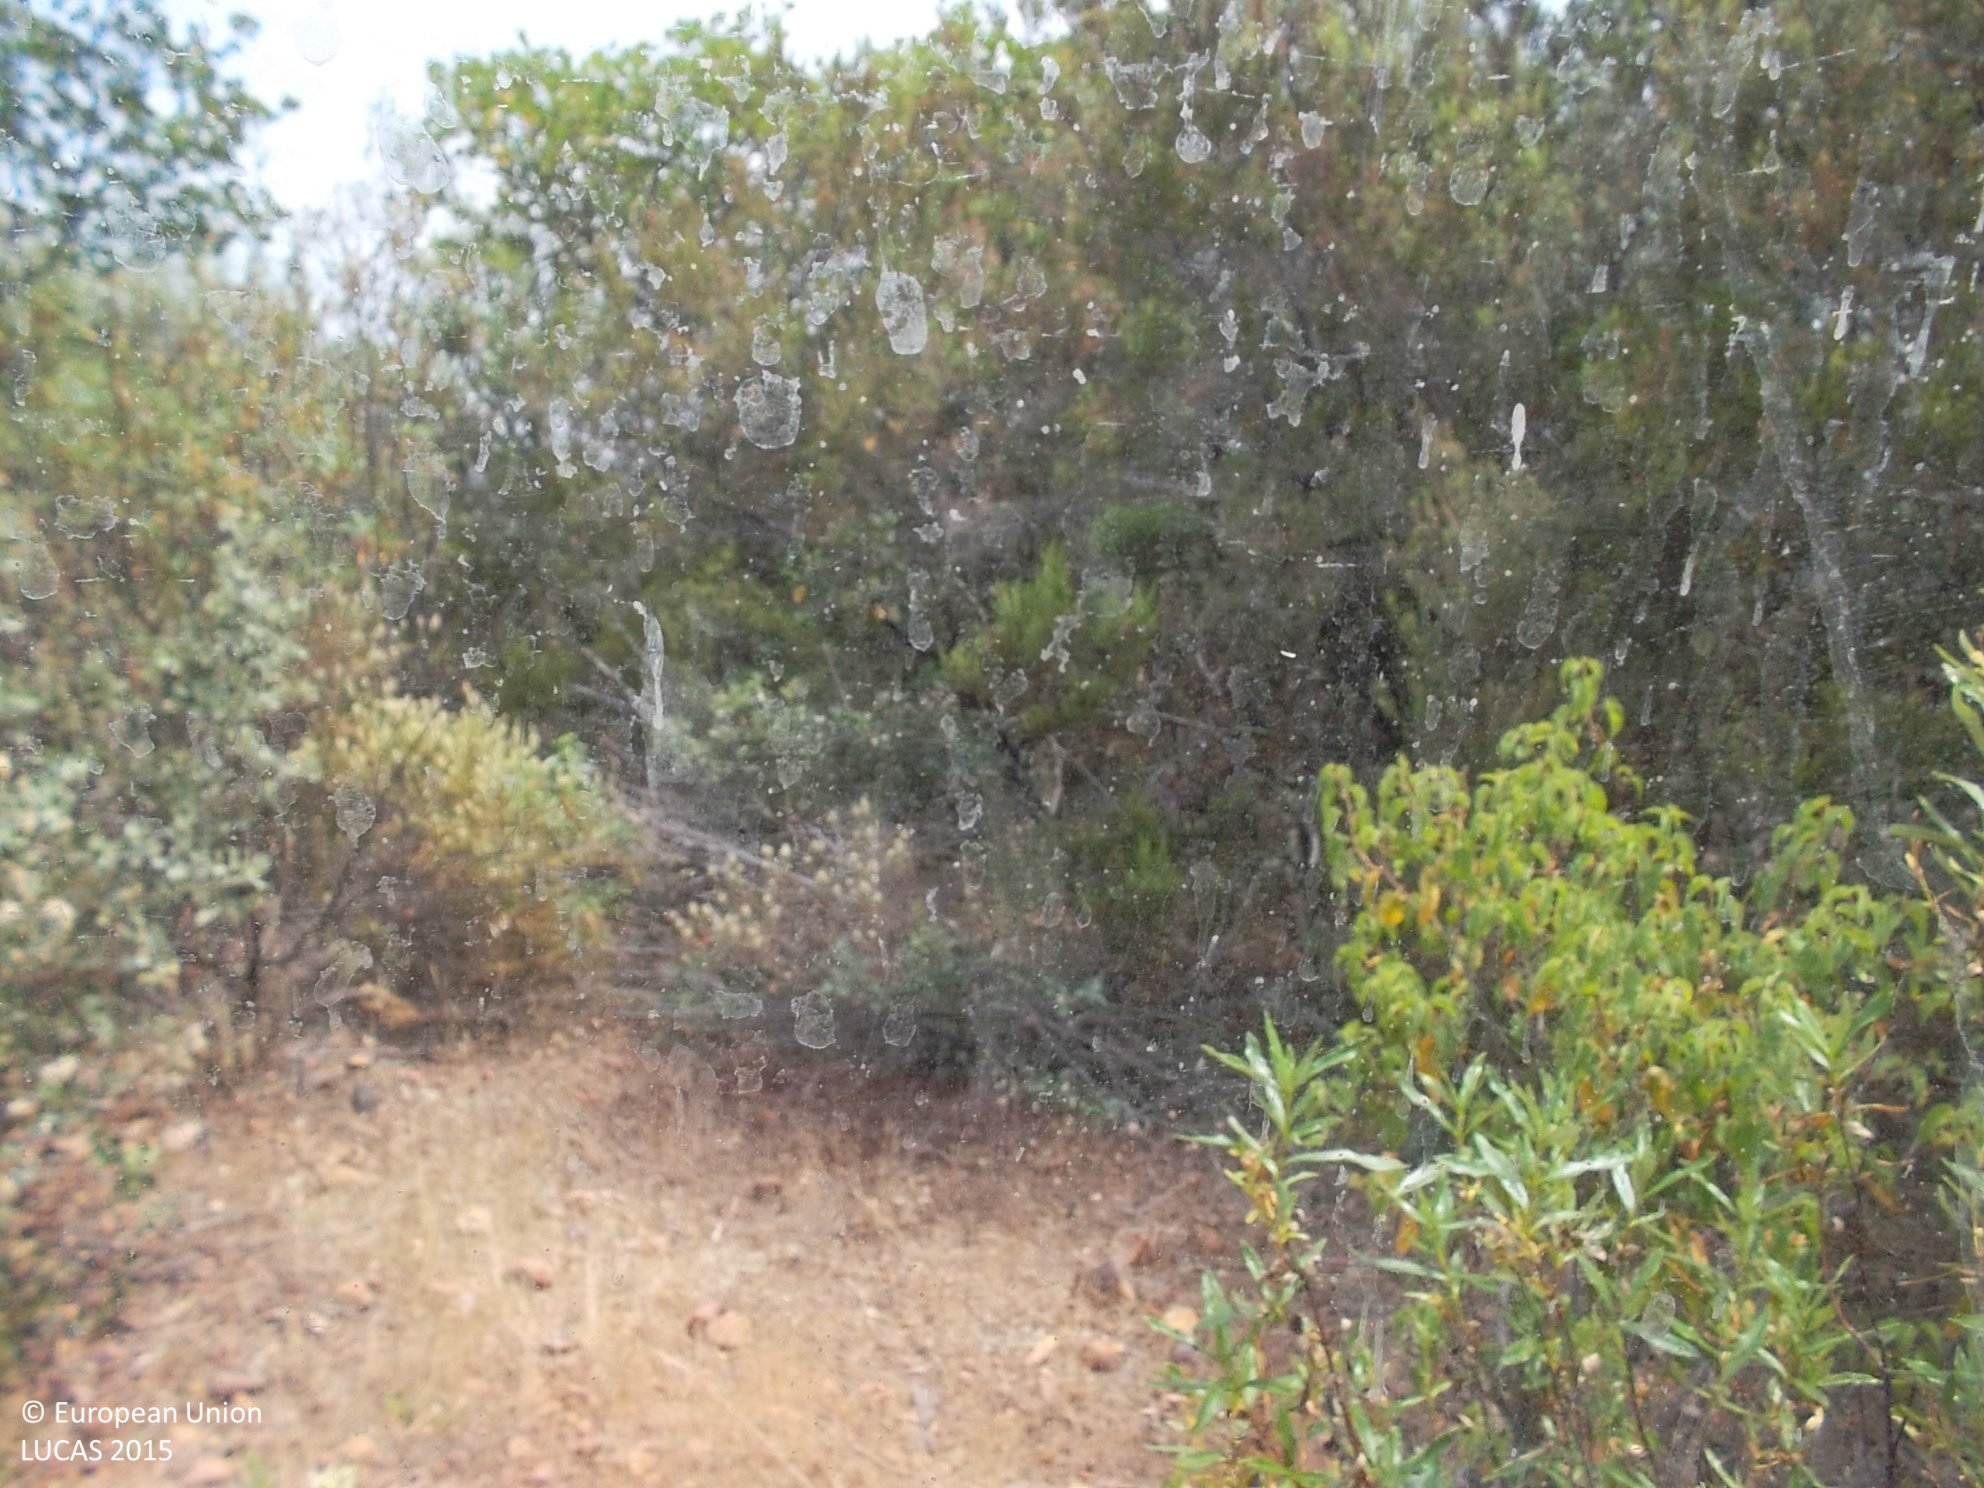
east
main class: Woodland
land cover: Broadleaved woodland
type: broadleaved evergreen forest
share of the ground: 50 - 75 %
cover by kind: shrubs 60 %, broadleaved forest trees 40 %
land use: Forestry
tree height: > 5 m
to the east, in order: Broadleaved woodland; Shrubland with sparse tree cover
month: June
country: ES
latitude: 39.1757
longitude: -4.9114
